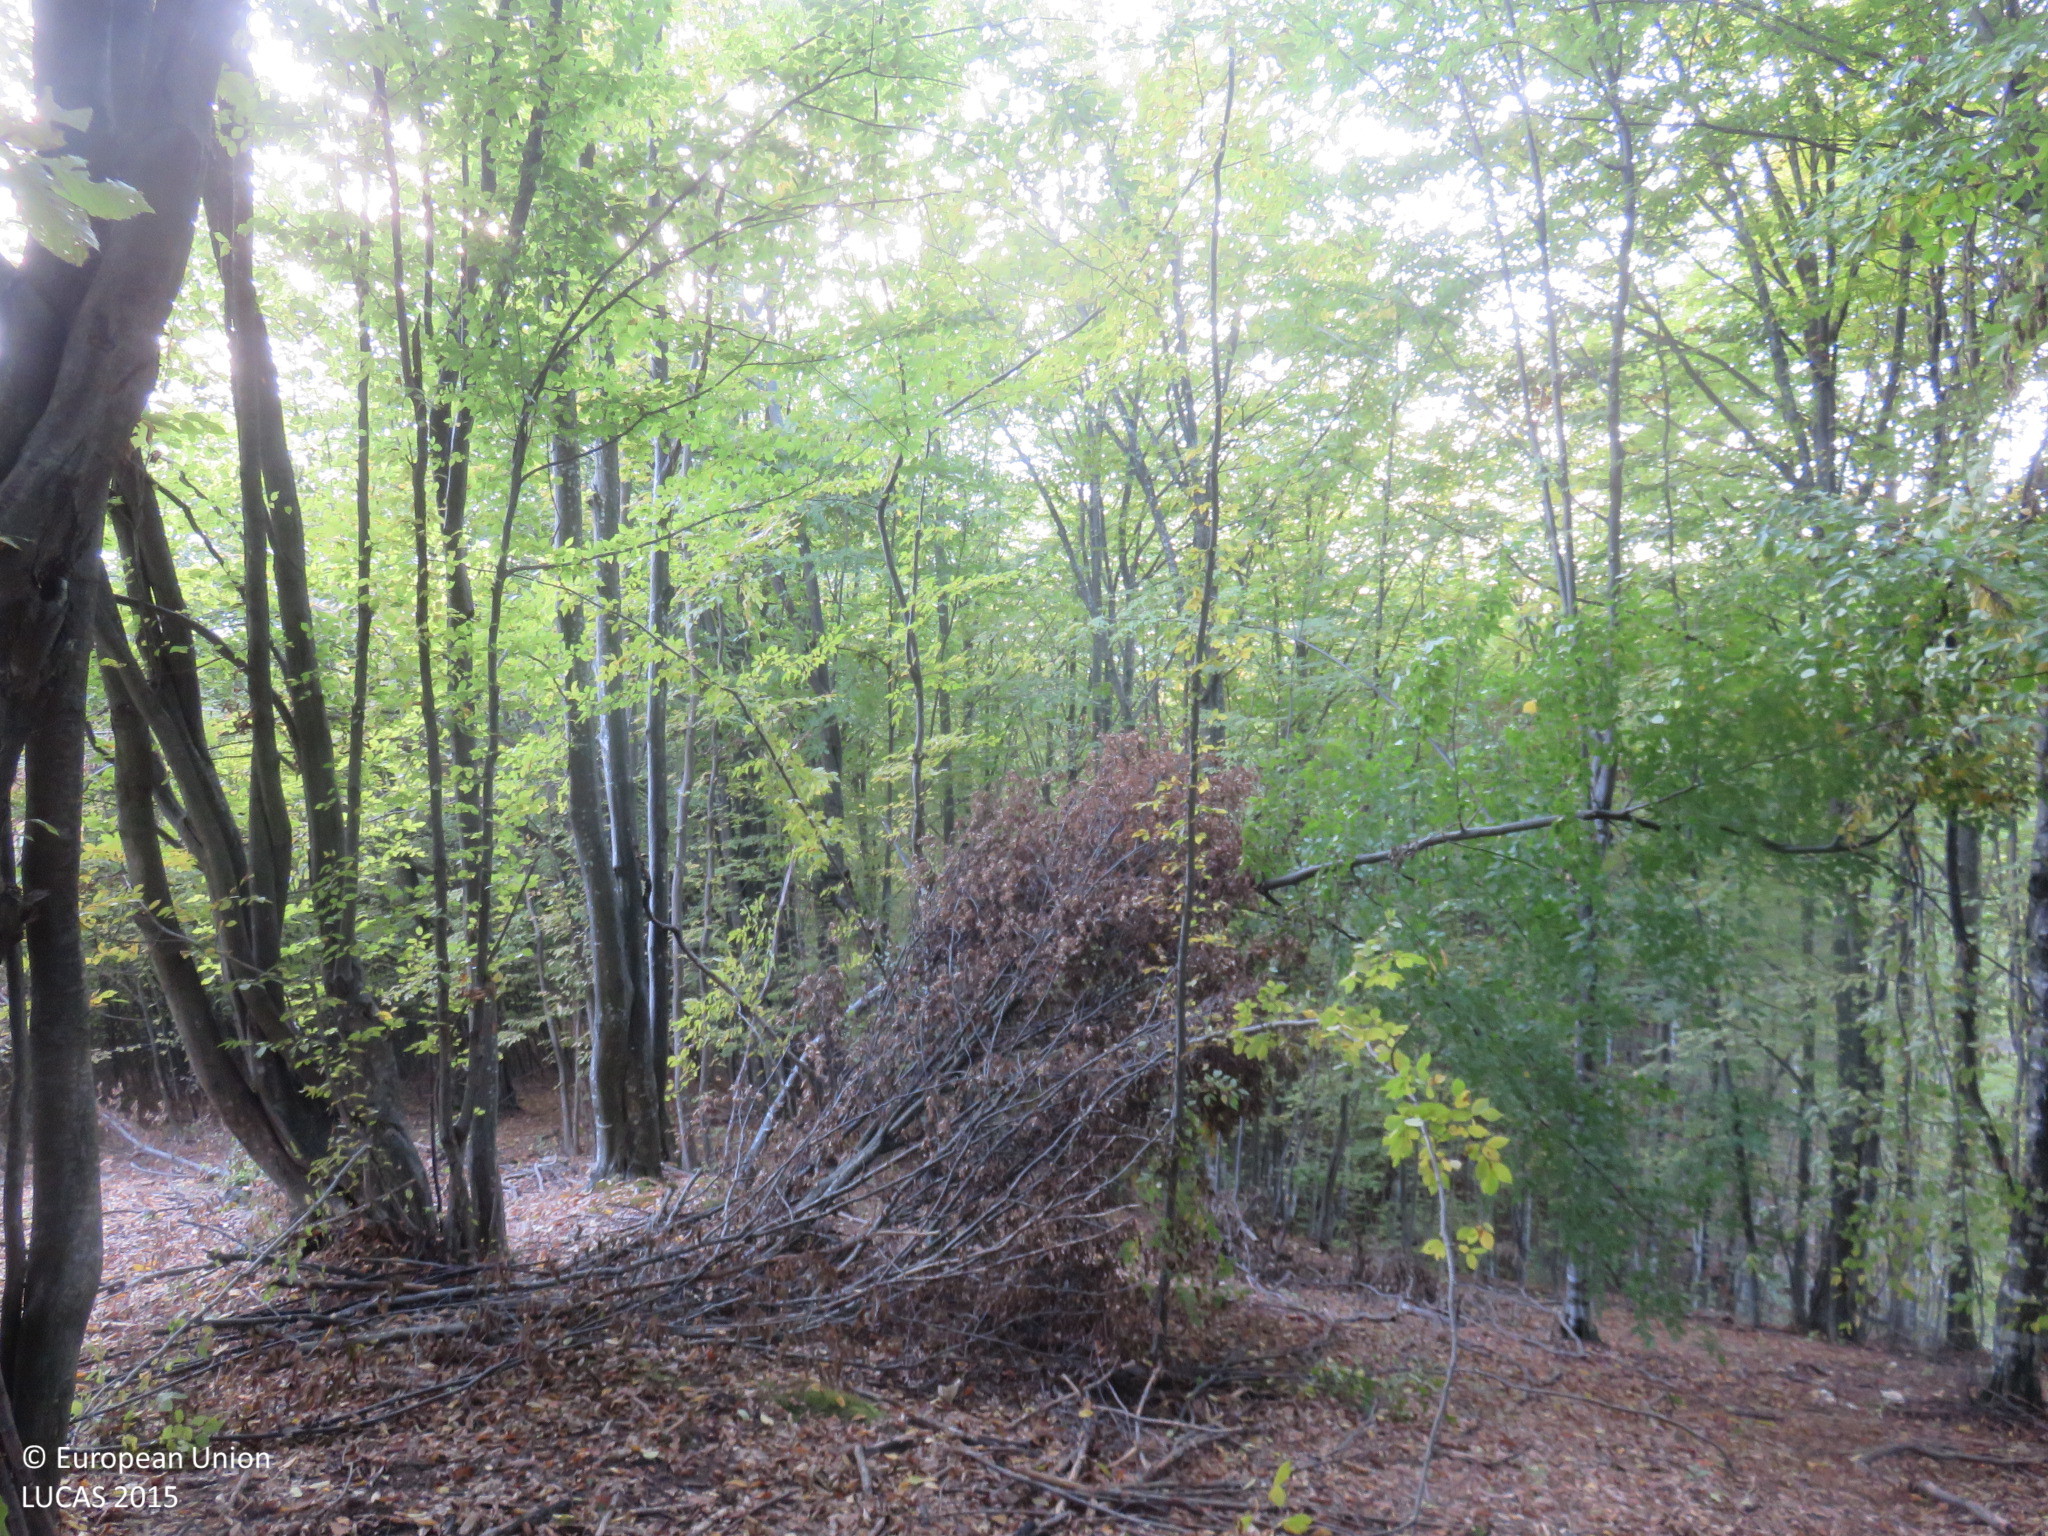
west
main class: Woodland
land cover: Broadleaved woodland
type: beech forest
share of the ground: > 75 %
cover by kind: broadleaved forest trees 95 %, shrubs 5 %
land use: Forestry
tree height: > 5 m
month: October
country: BG
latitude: 42.8384
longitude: 24.9528
